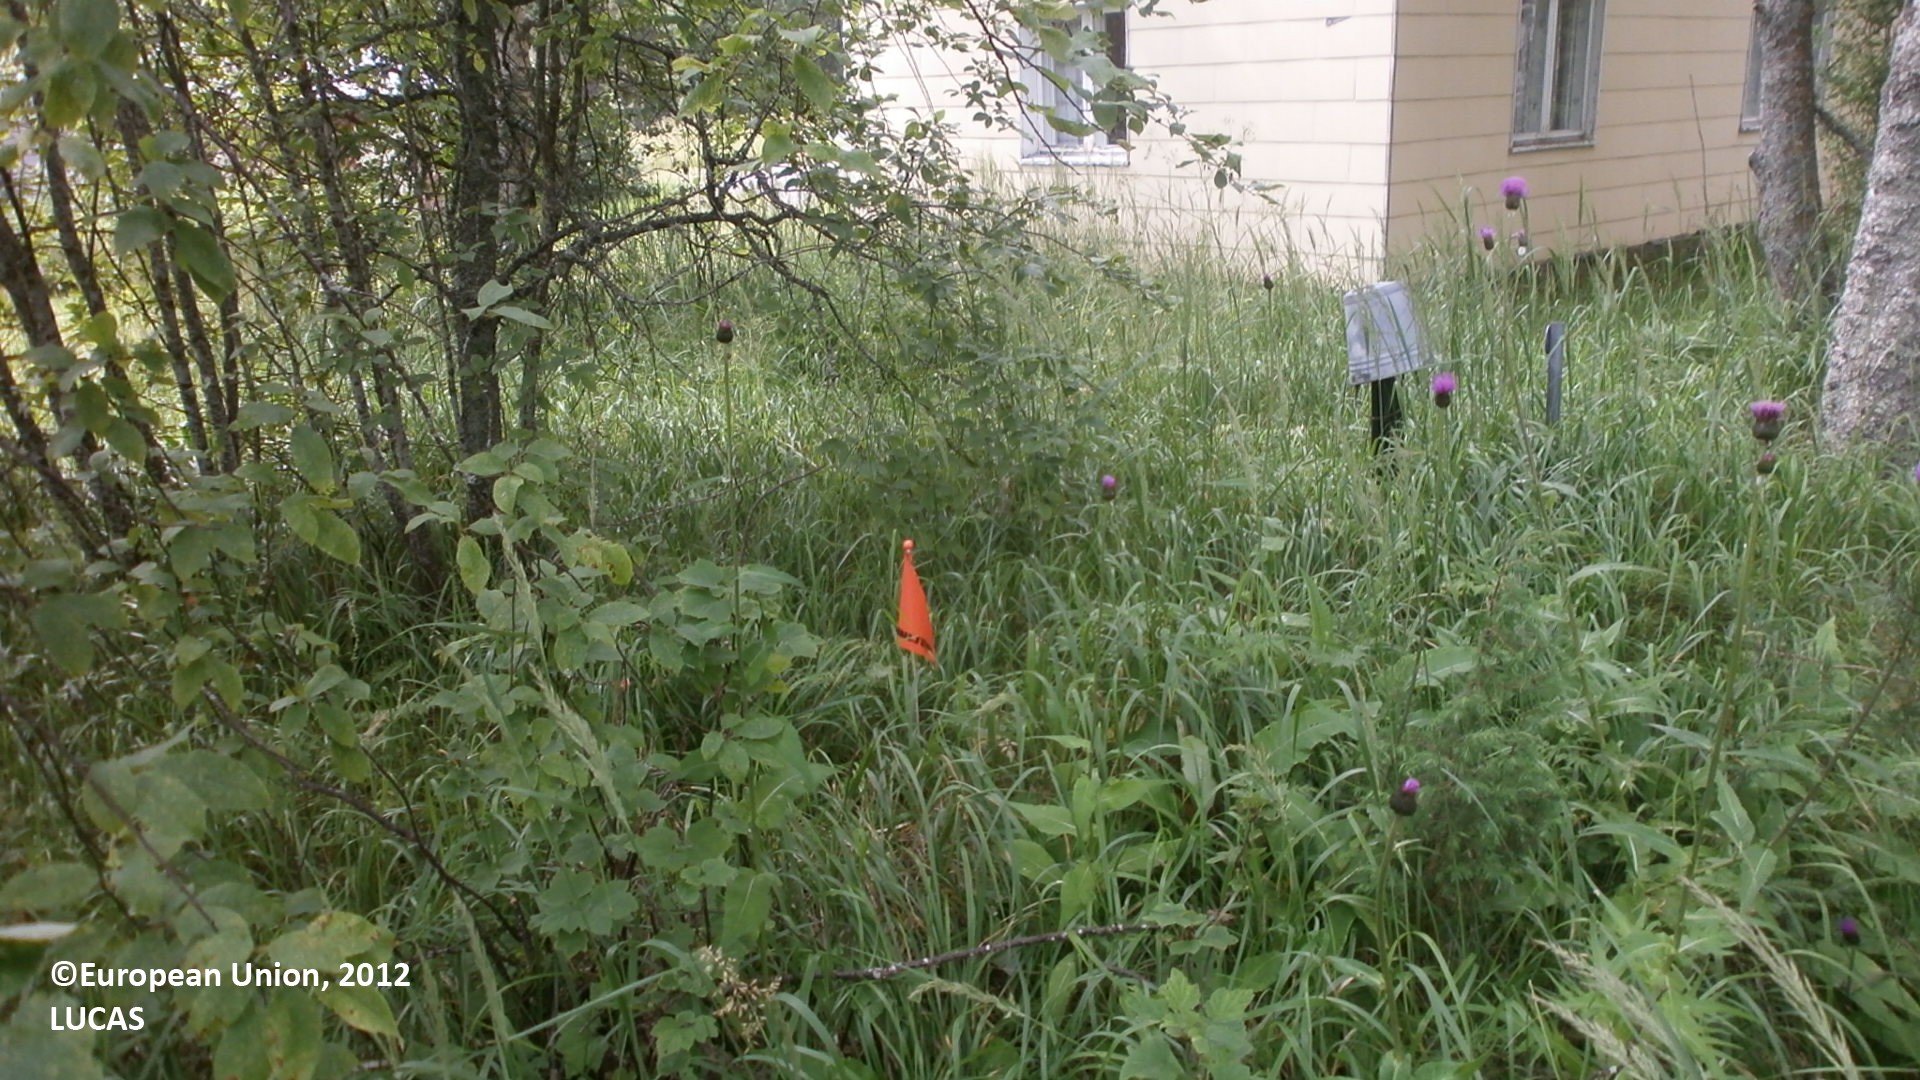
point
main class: Woodland
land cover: Broadleaved woodland
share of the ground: 10 - 25 %
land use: Residential
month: July
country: FI
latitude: 64.2555
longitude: 24.3690
